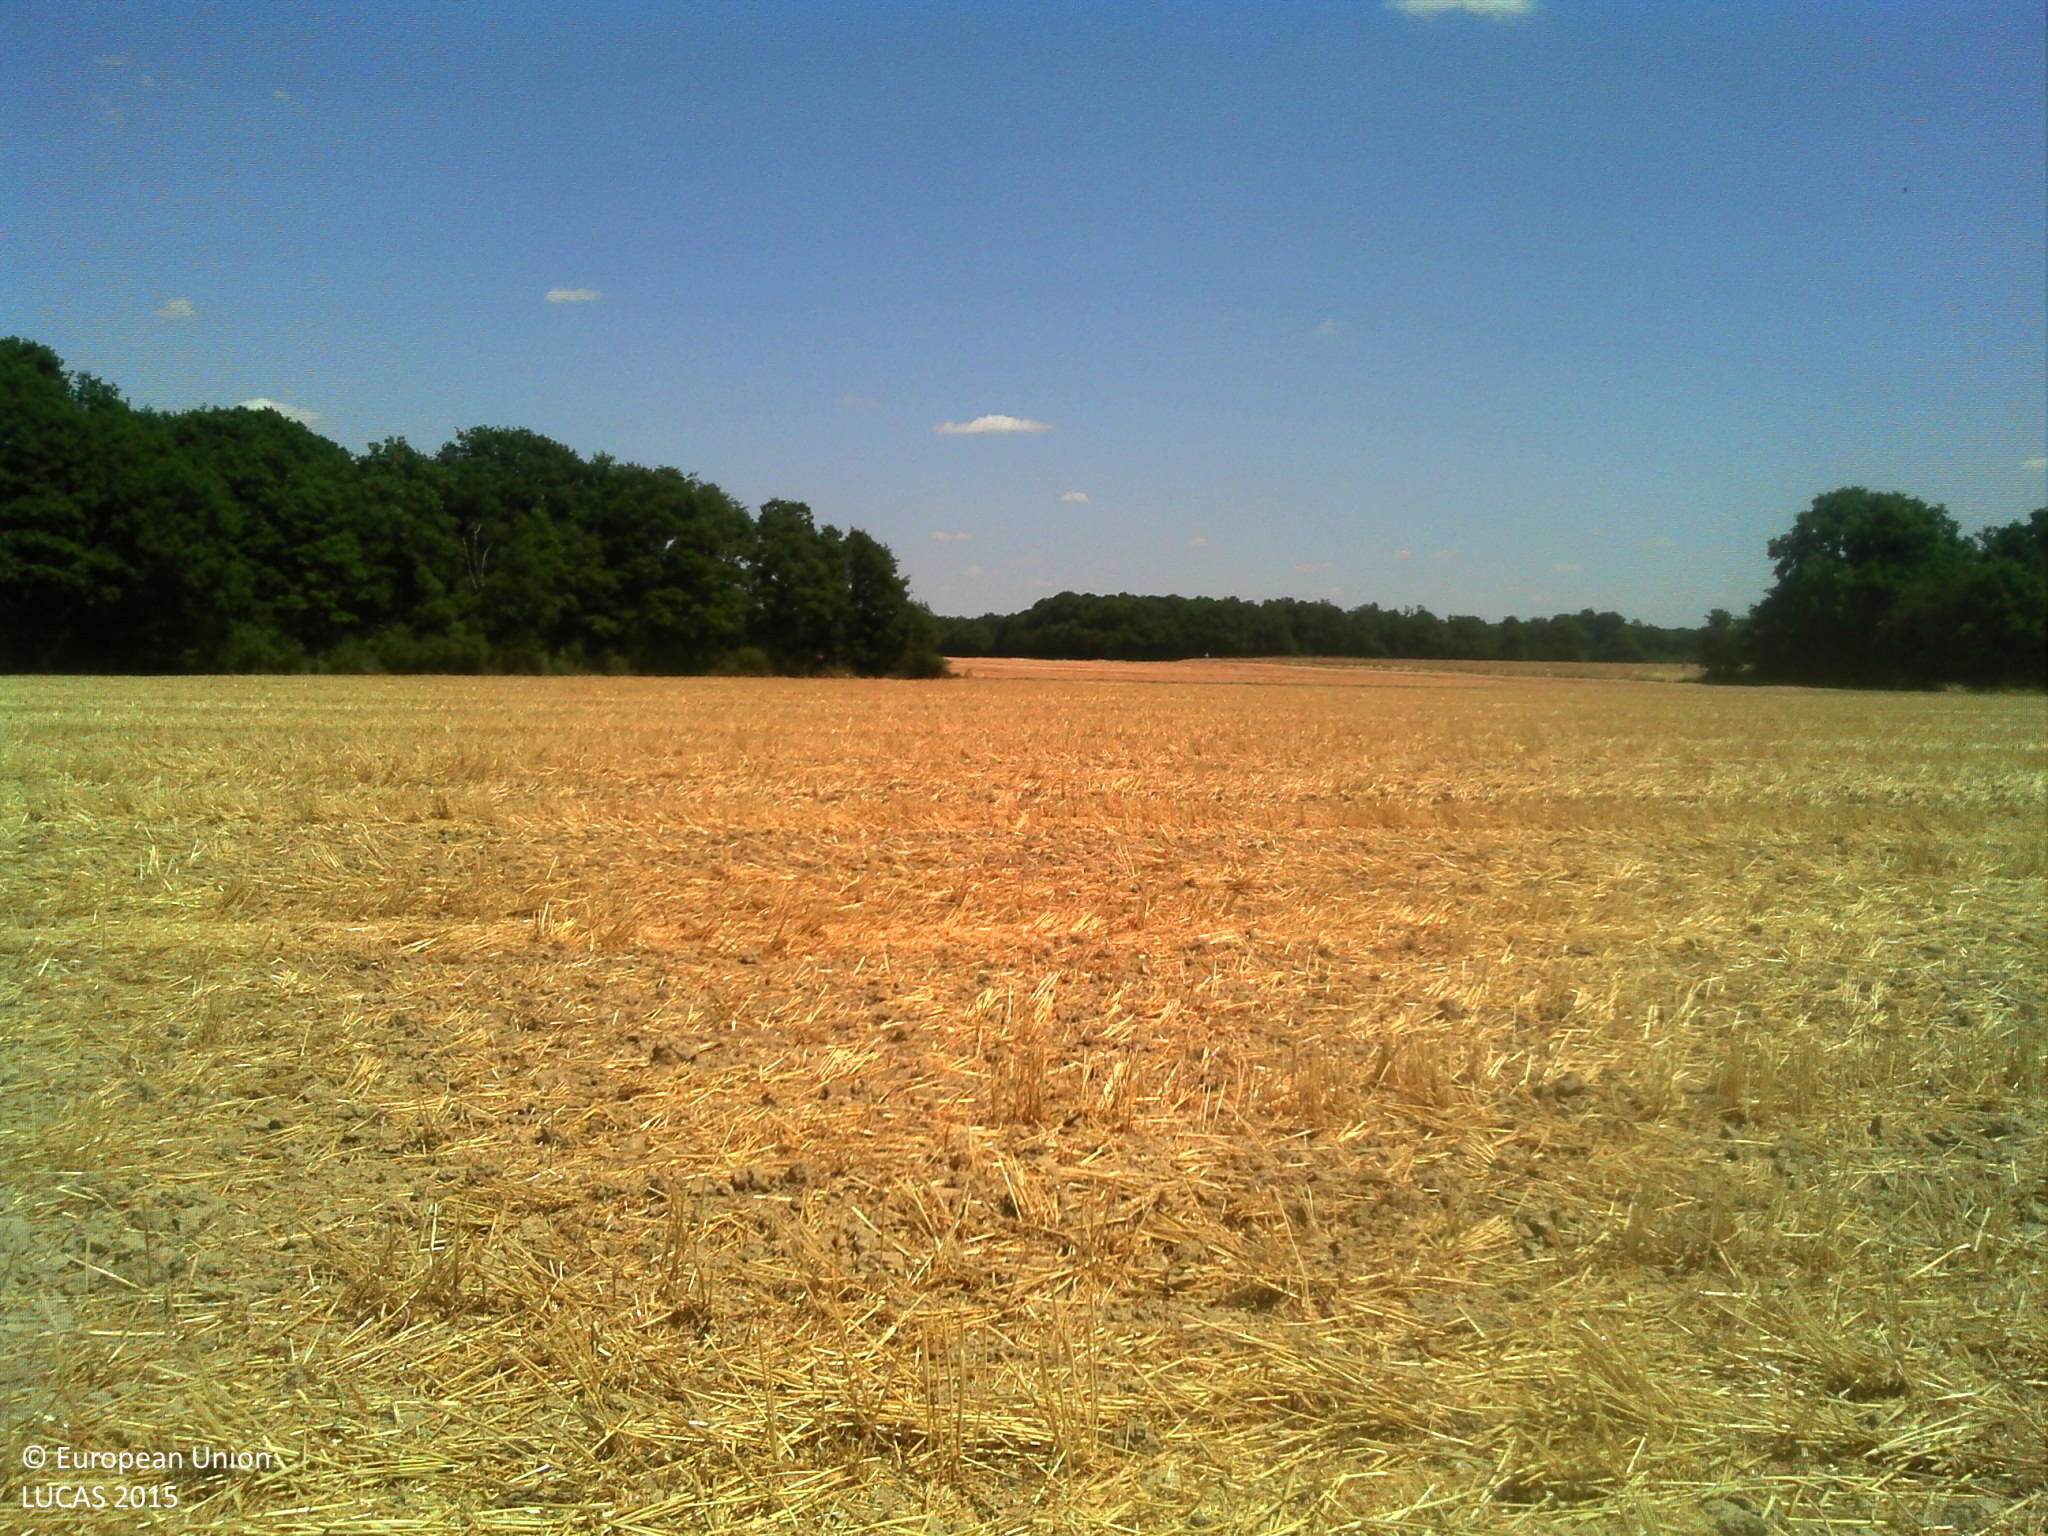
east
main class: Cropland
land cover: Barley
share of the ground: > 75 %
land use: Agriculture (excluding fallow land and kitchen gardens)
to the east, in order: Barley; Tracks; Ditches and canals; Broadleaved woodland; Tracks; Common wheat
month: July
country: FR
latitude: 48.1694
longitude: 1.3096
